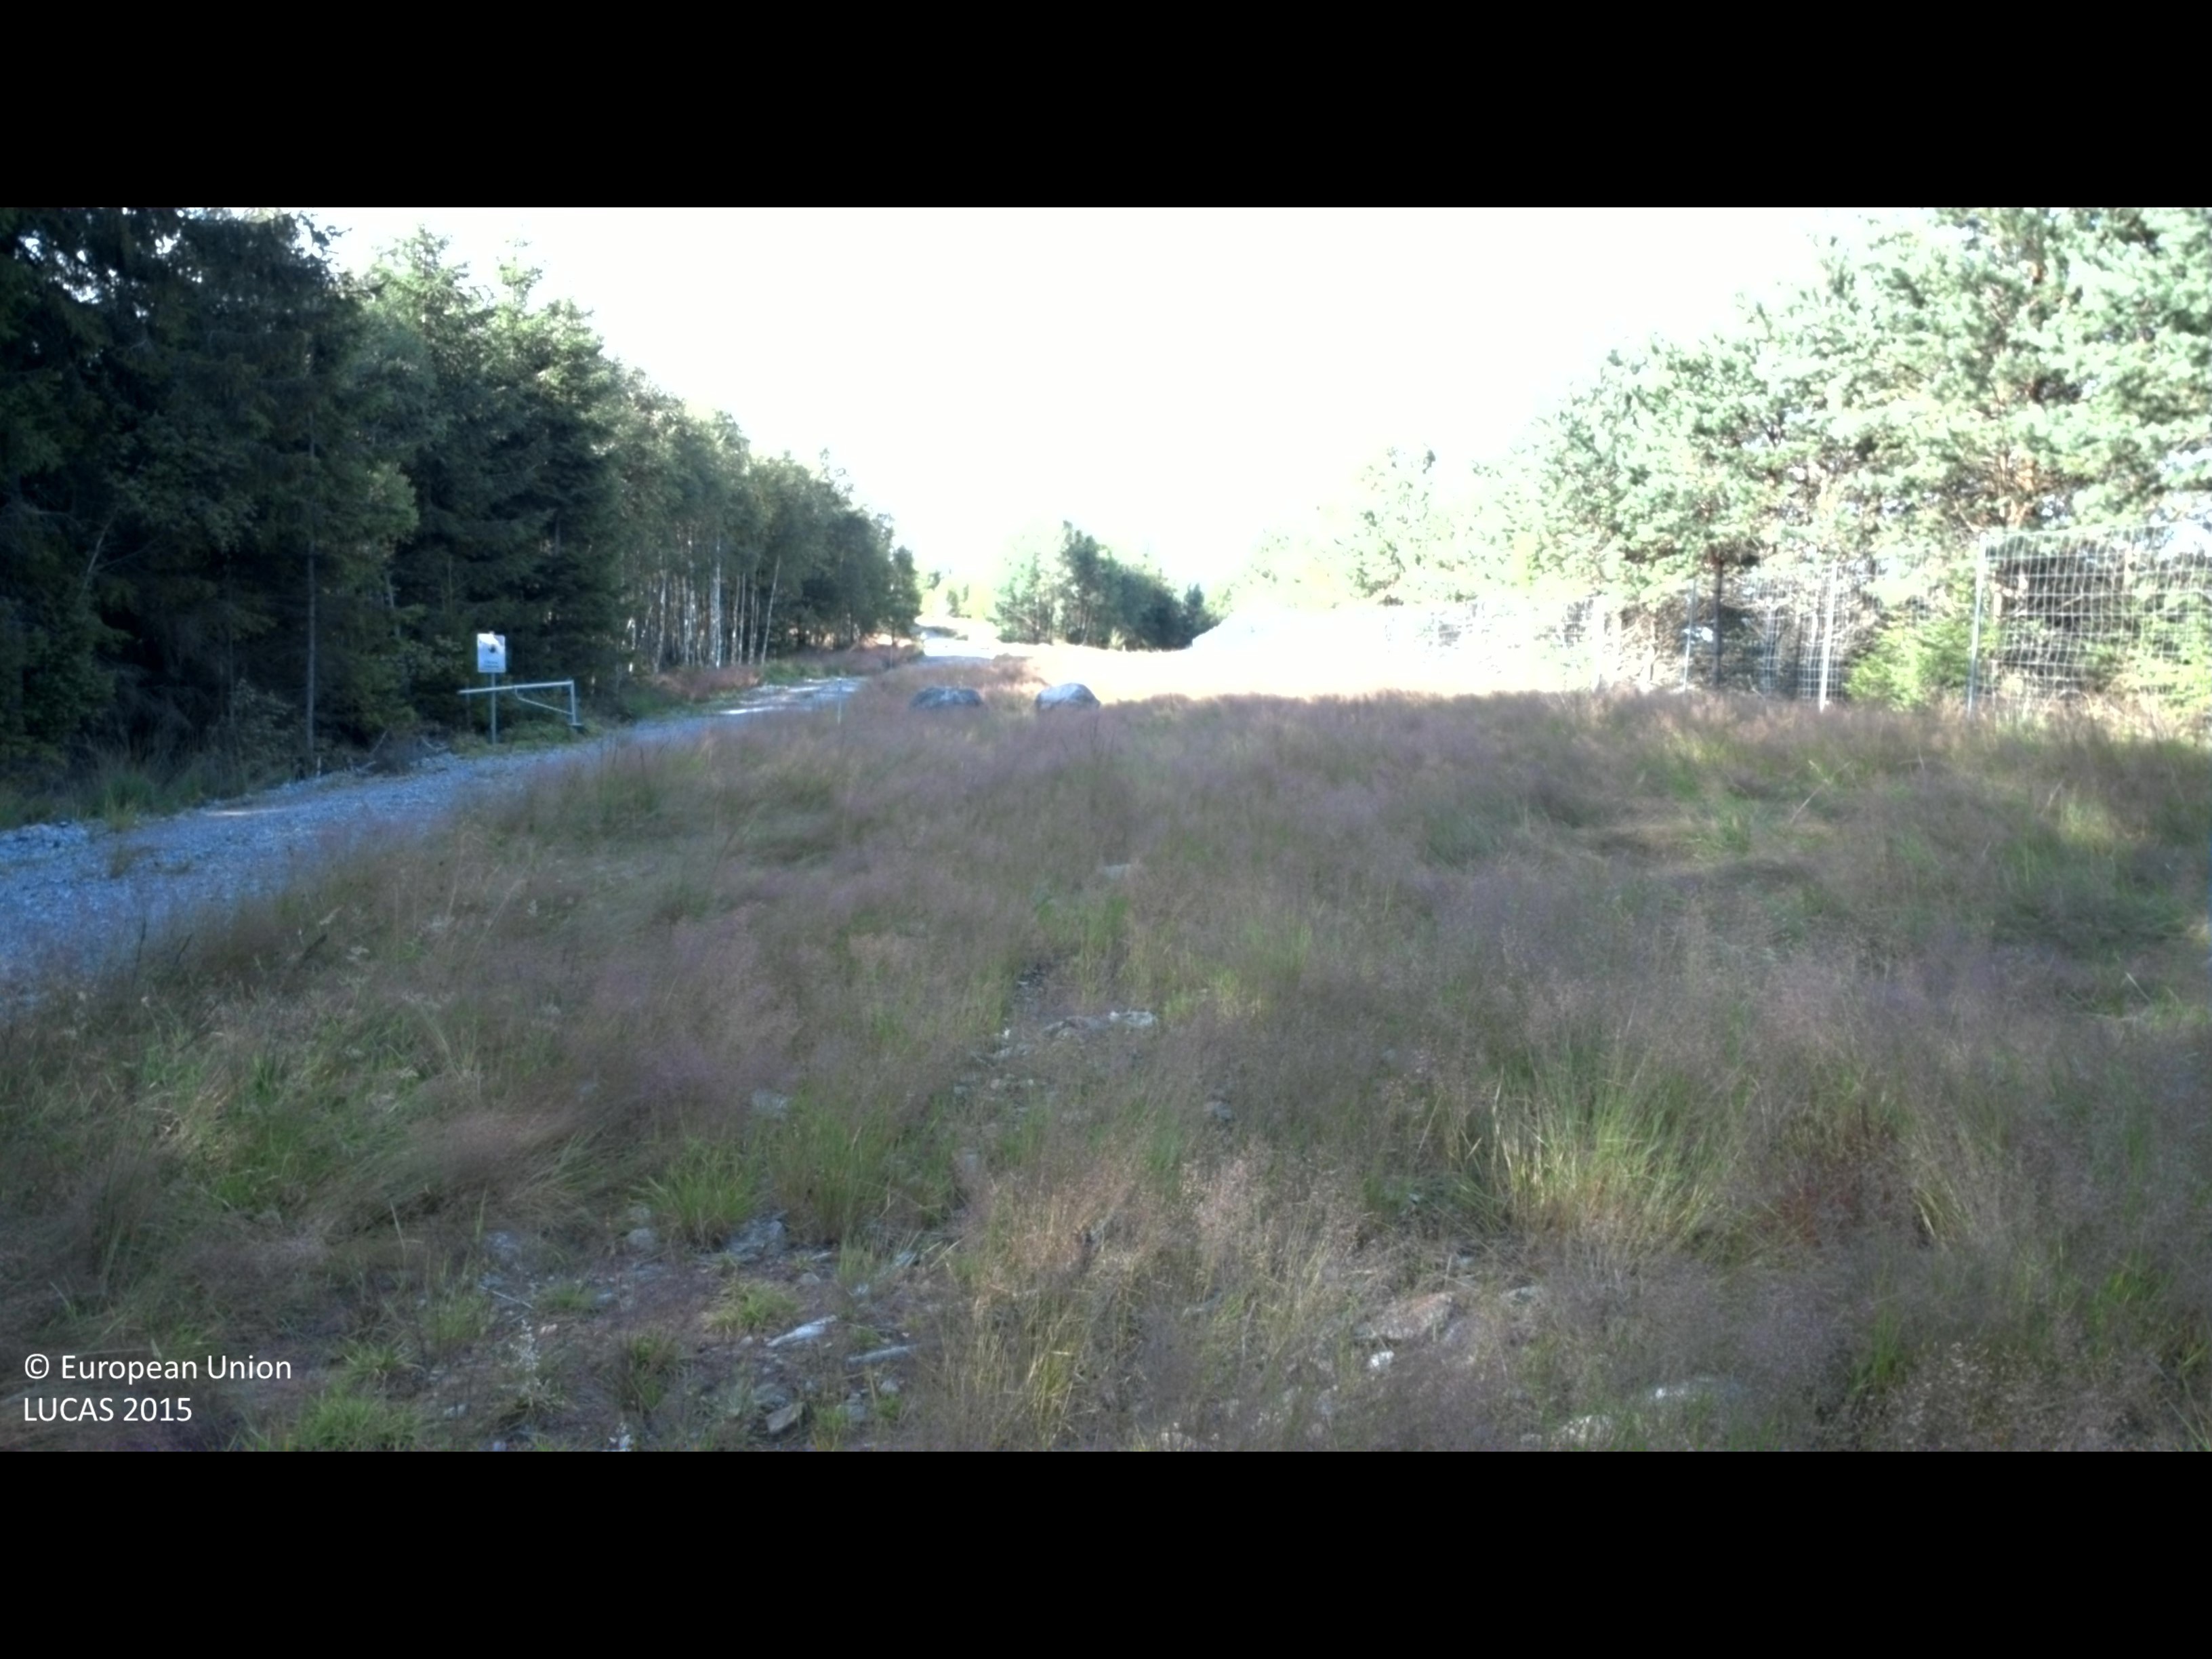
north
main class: Grassland
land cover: Grassland without tree/shrub cover
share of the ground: > 75 %
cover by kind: herbaceous plants 90 %, unconsolidated bare surface 10 %
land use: Forestry
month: August
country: SE
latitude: 56.6885
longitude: 13.8335
